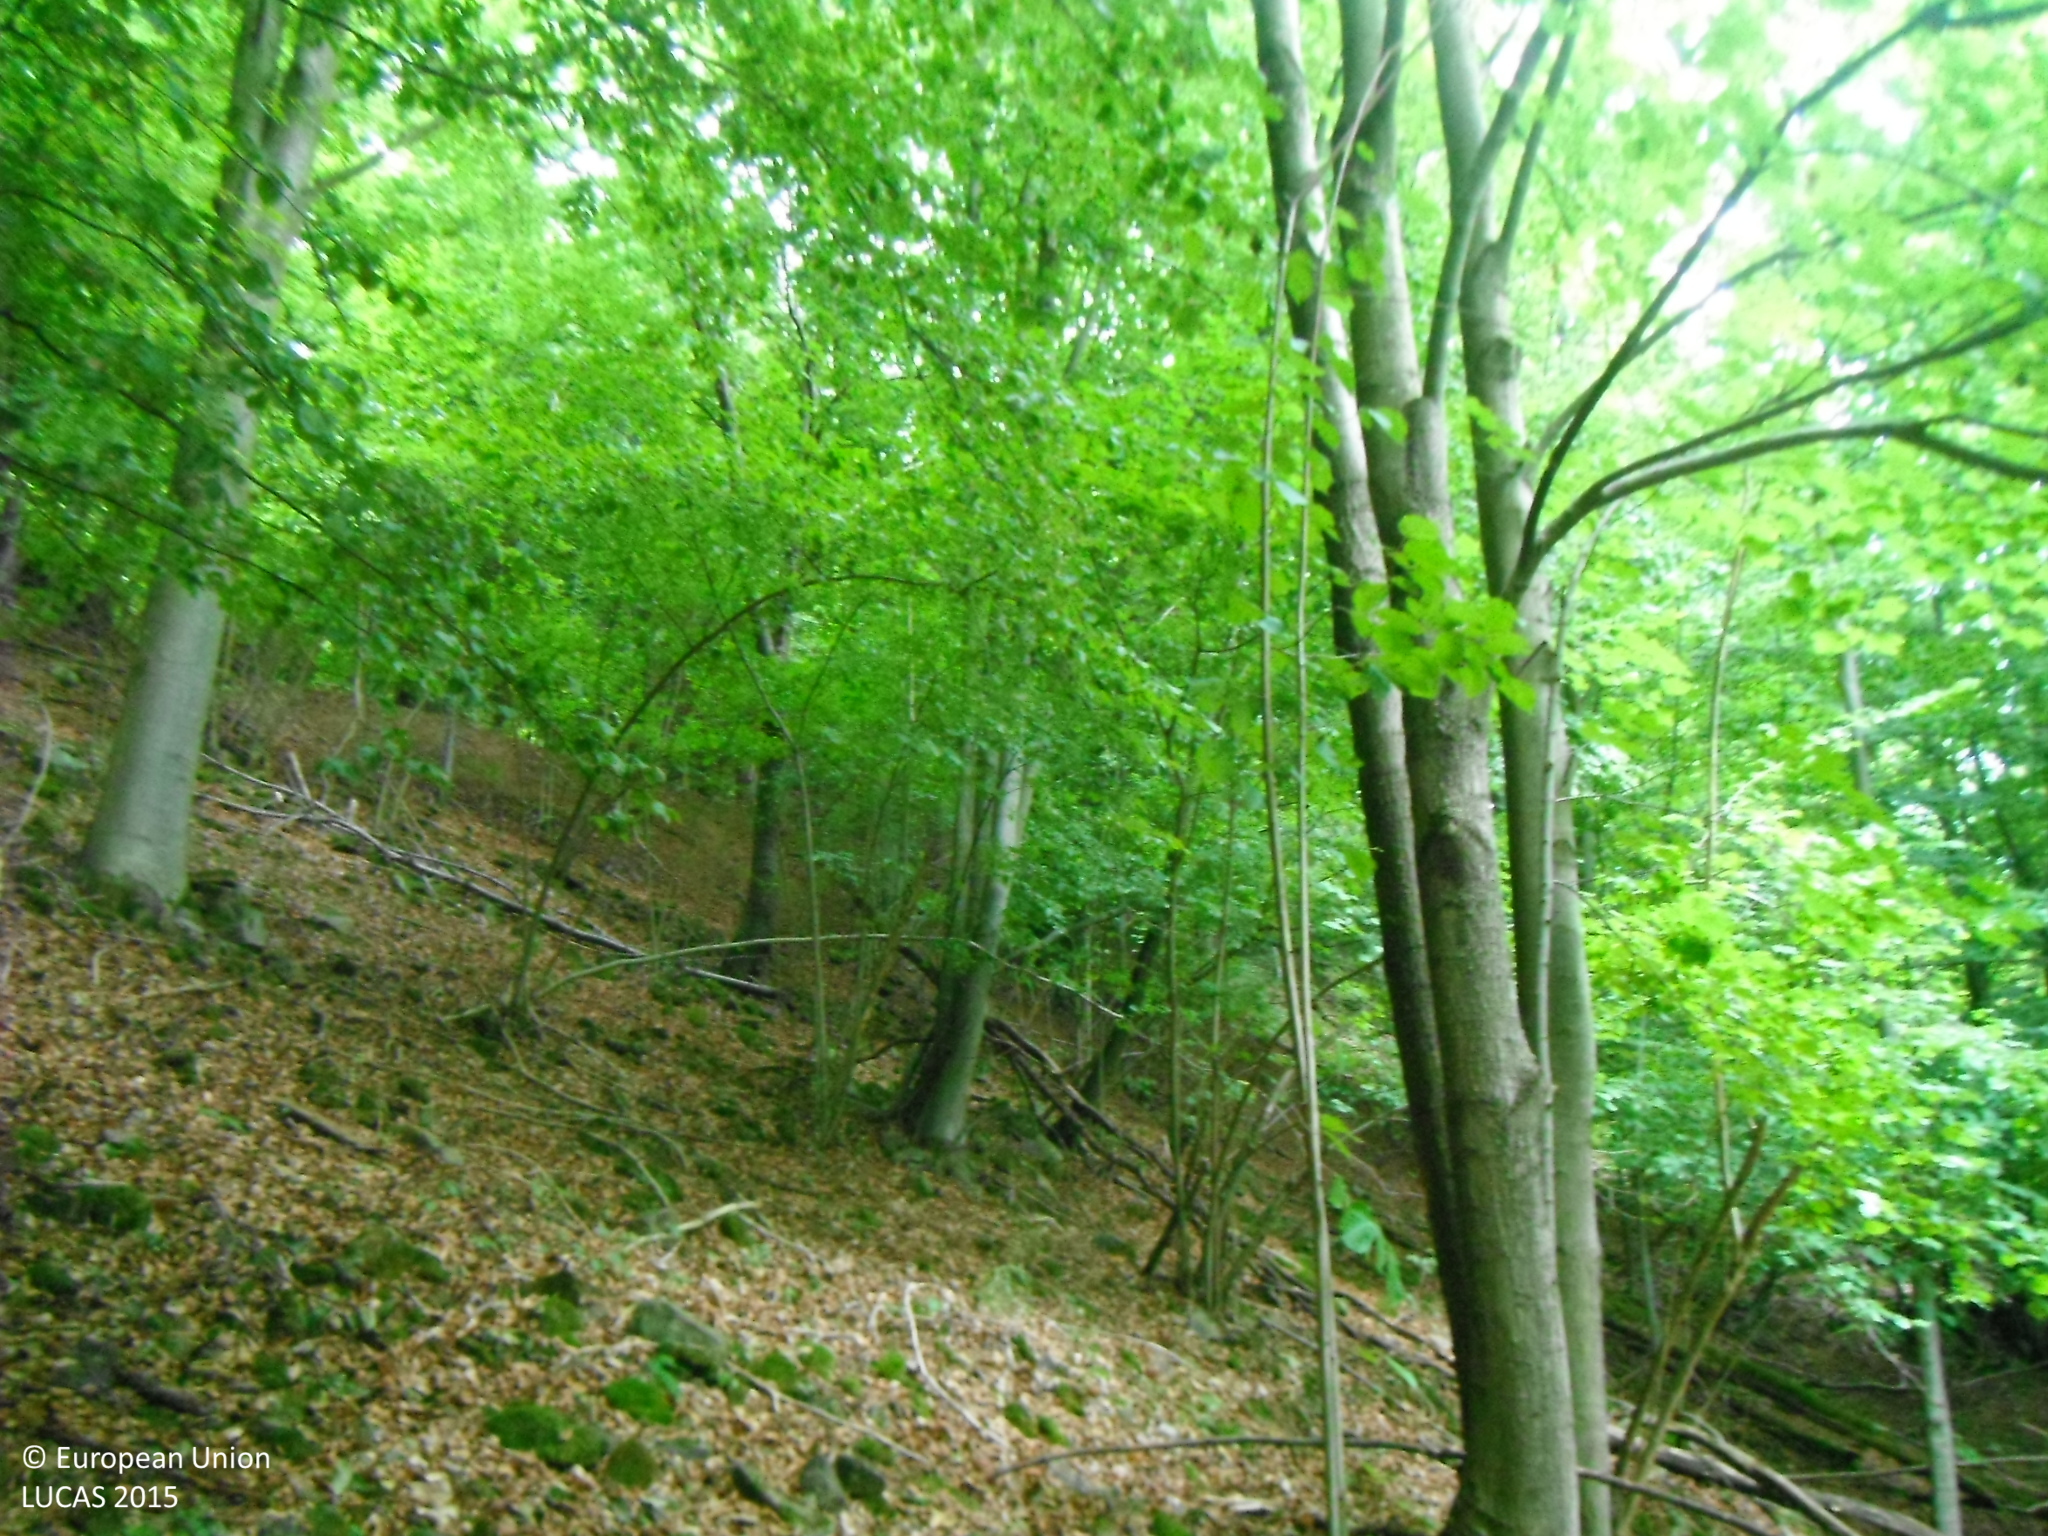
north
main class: Woodland
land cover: Broadleaved woodland
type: mountainous beech forest
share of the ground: > 75 %
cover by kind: broadleaved forest trees 95 %, unconsolidated bare surface 5 %
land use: Forestry
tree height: > 5 m
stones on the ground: > 50 %
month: July
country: SK
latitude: 49.2663
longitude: 18.3035
